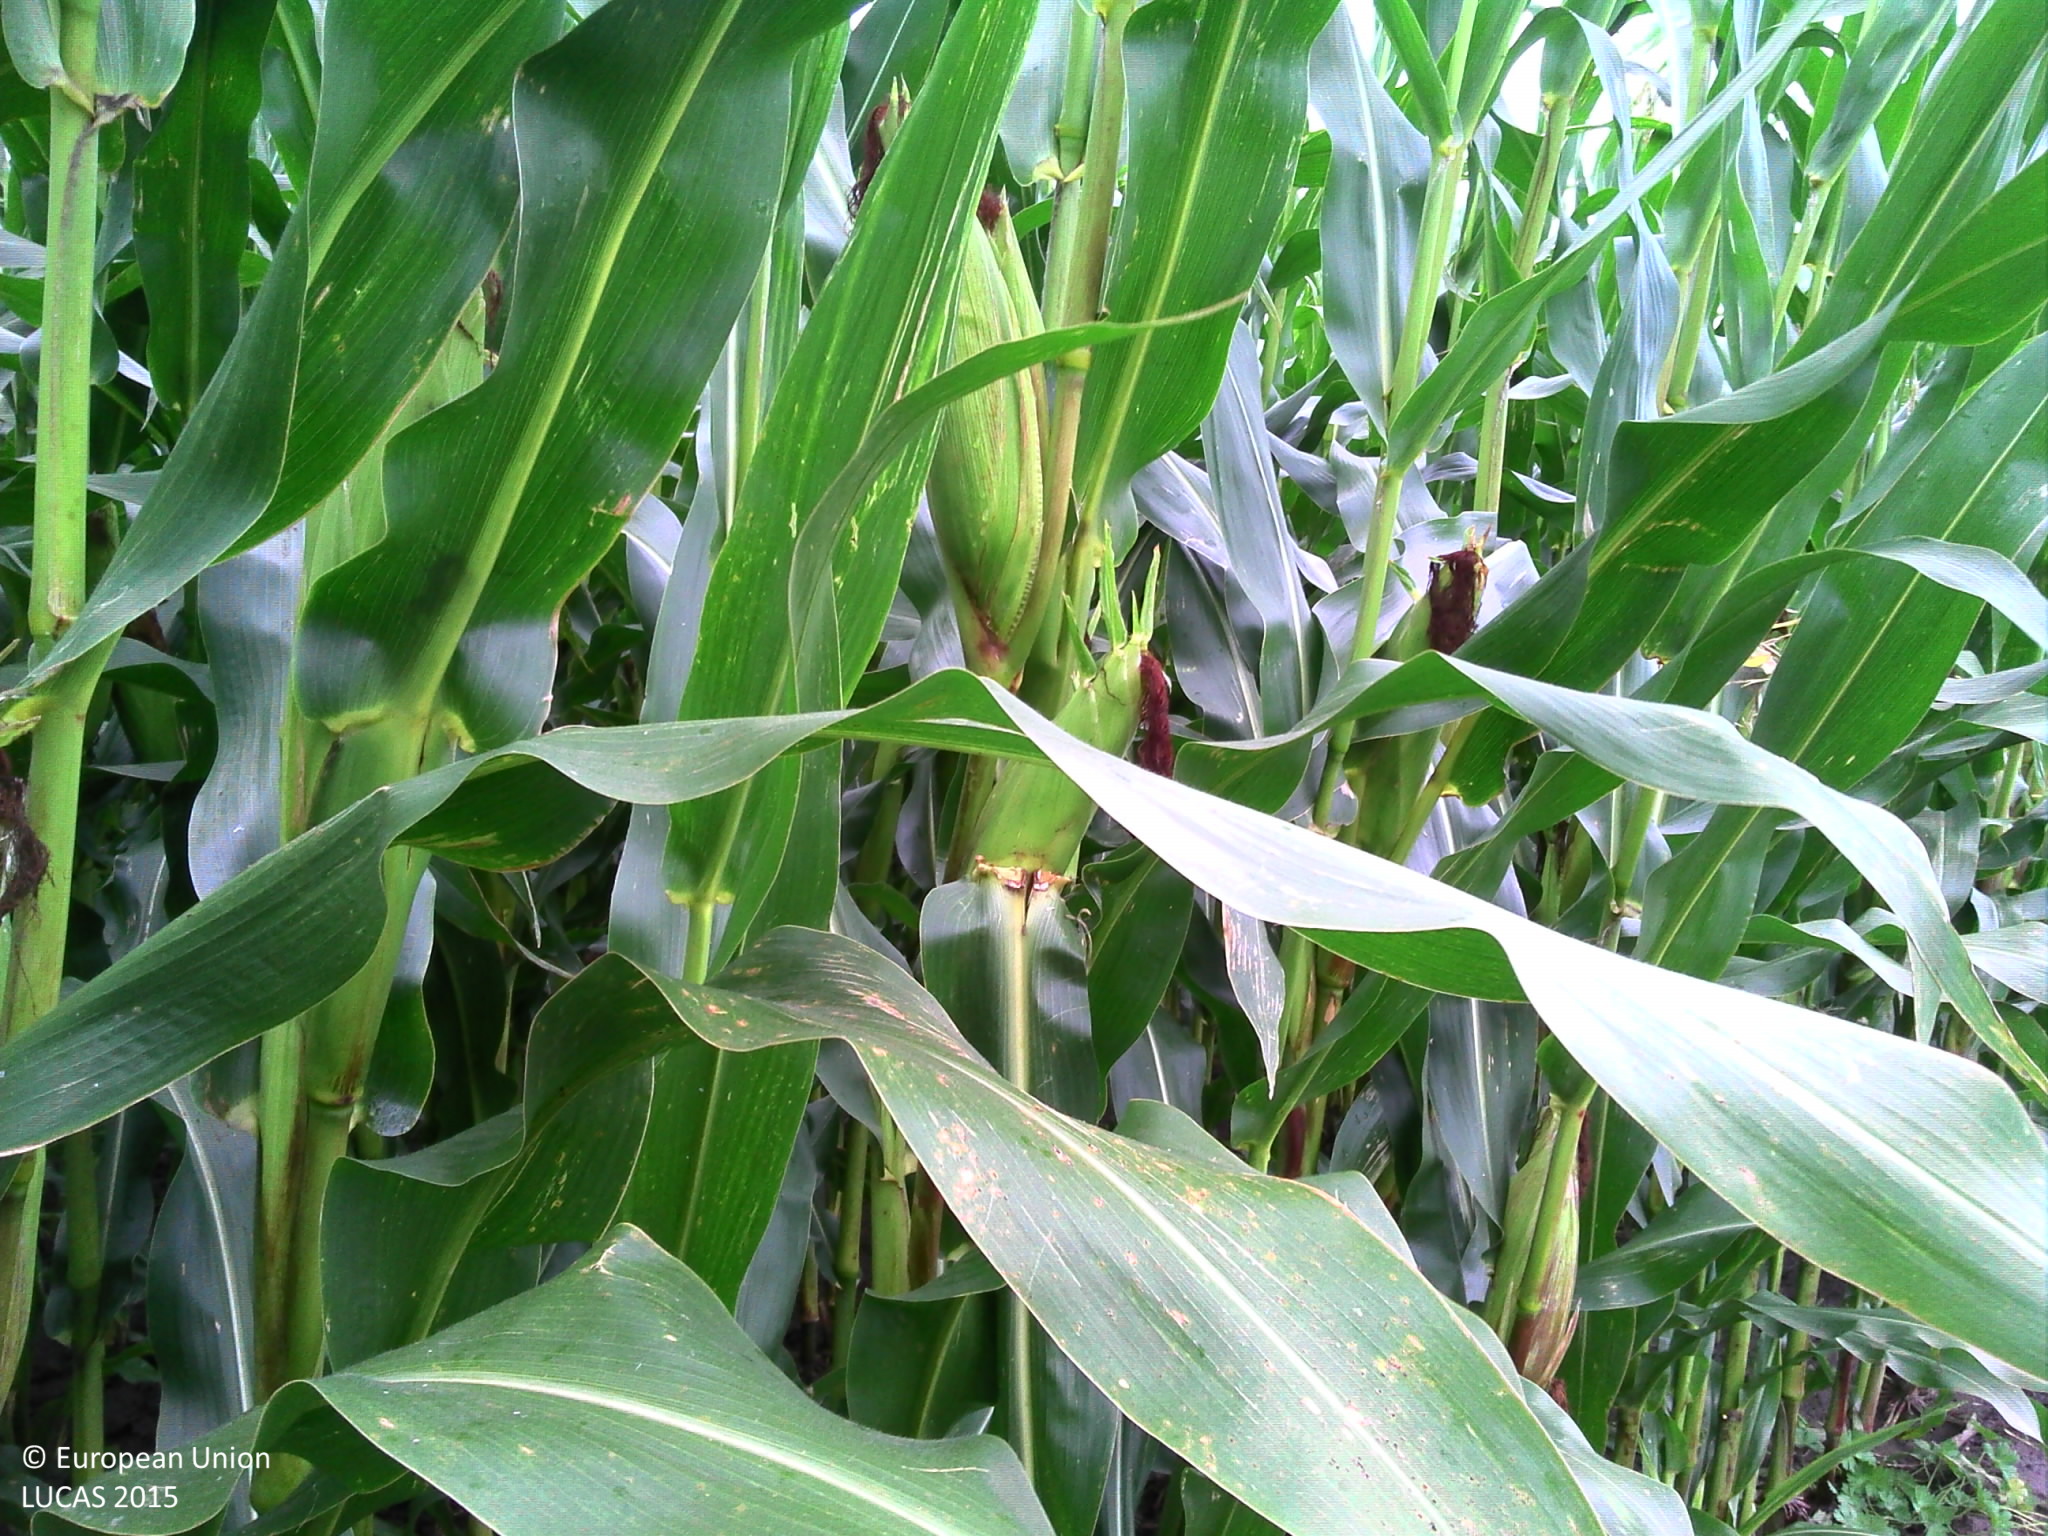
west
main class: Cropland
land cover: Maize
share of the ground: > 75 %
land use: Agriculture (excluding fallow land and kitchen gardens)
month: September
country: BE
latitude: 51.1294
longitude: 3.0884
